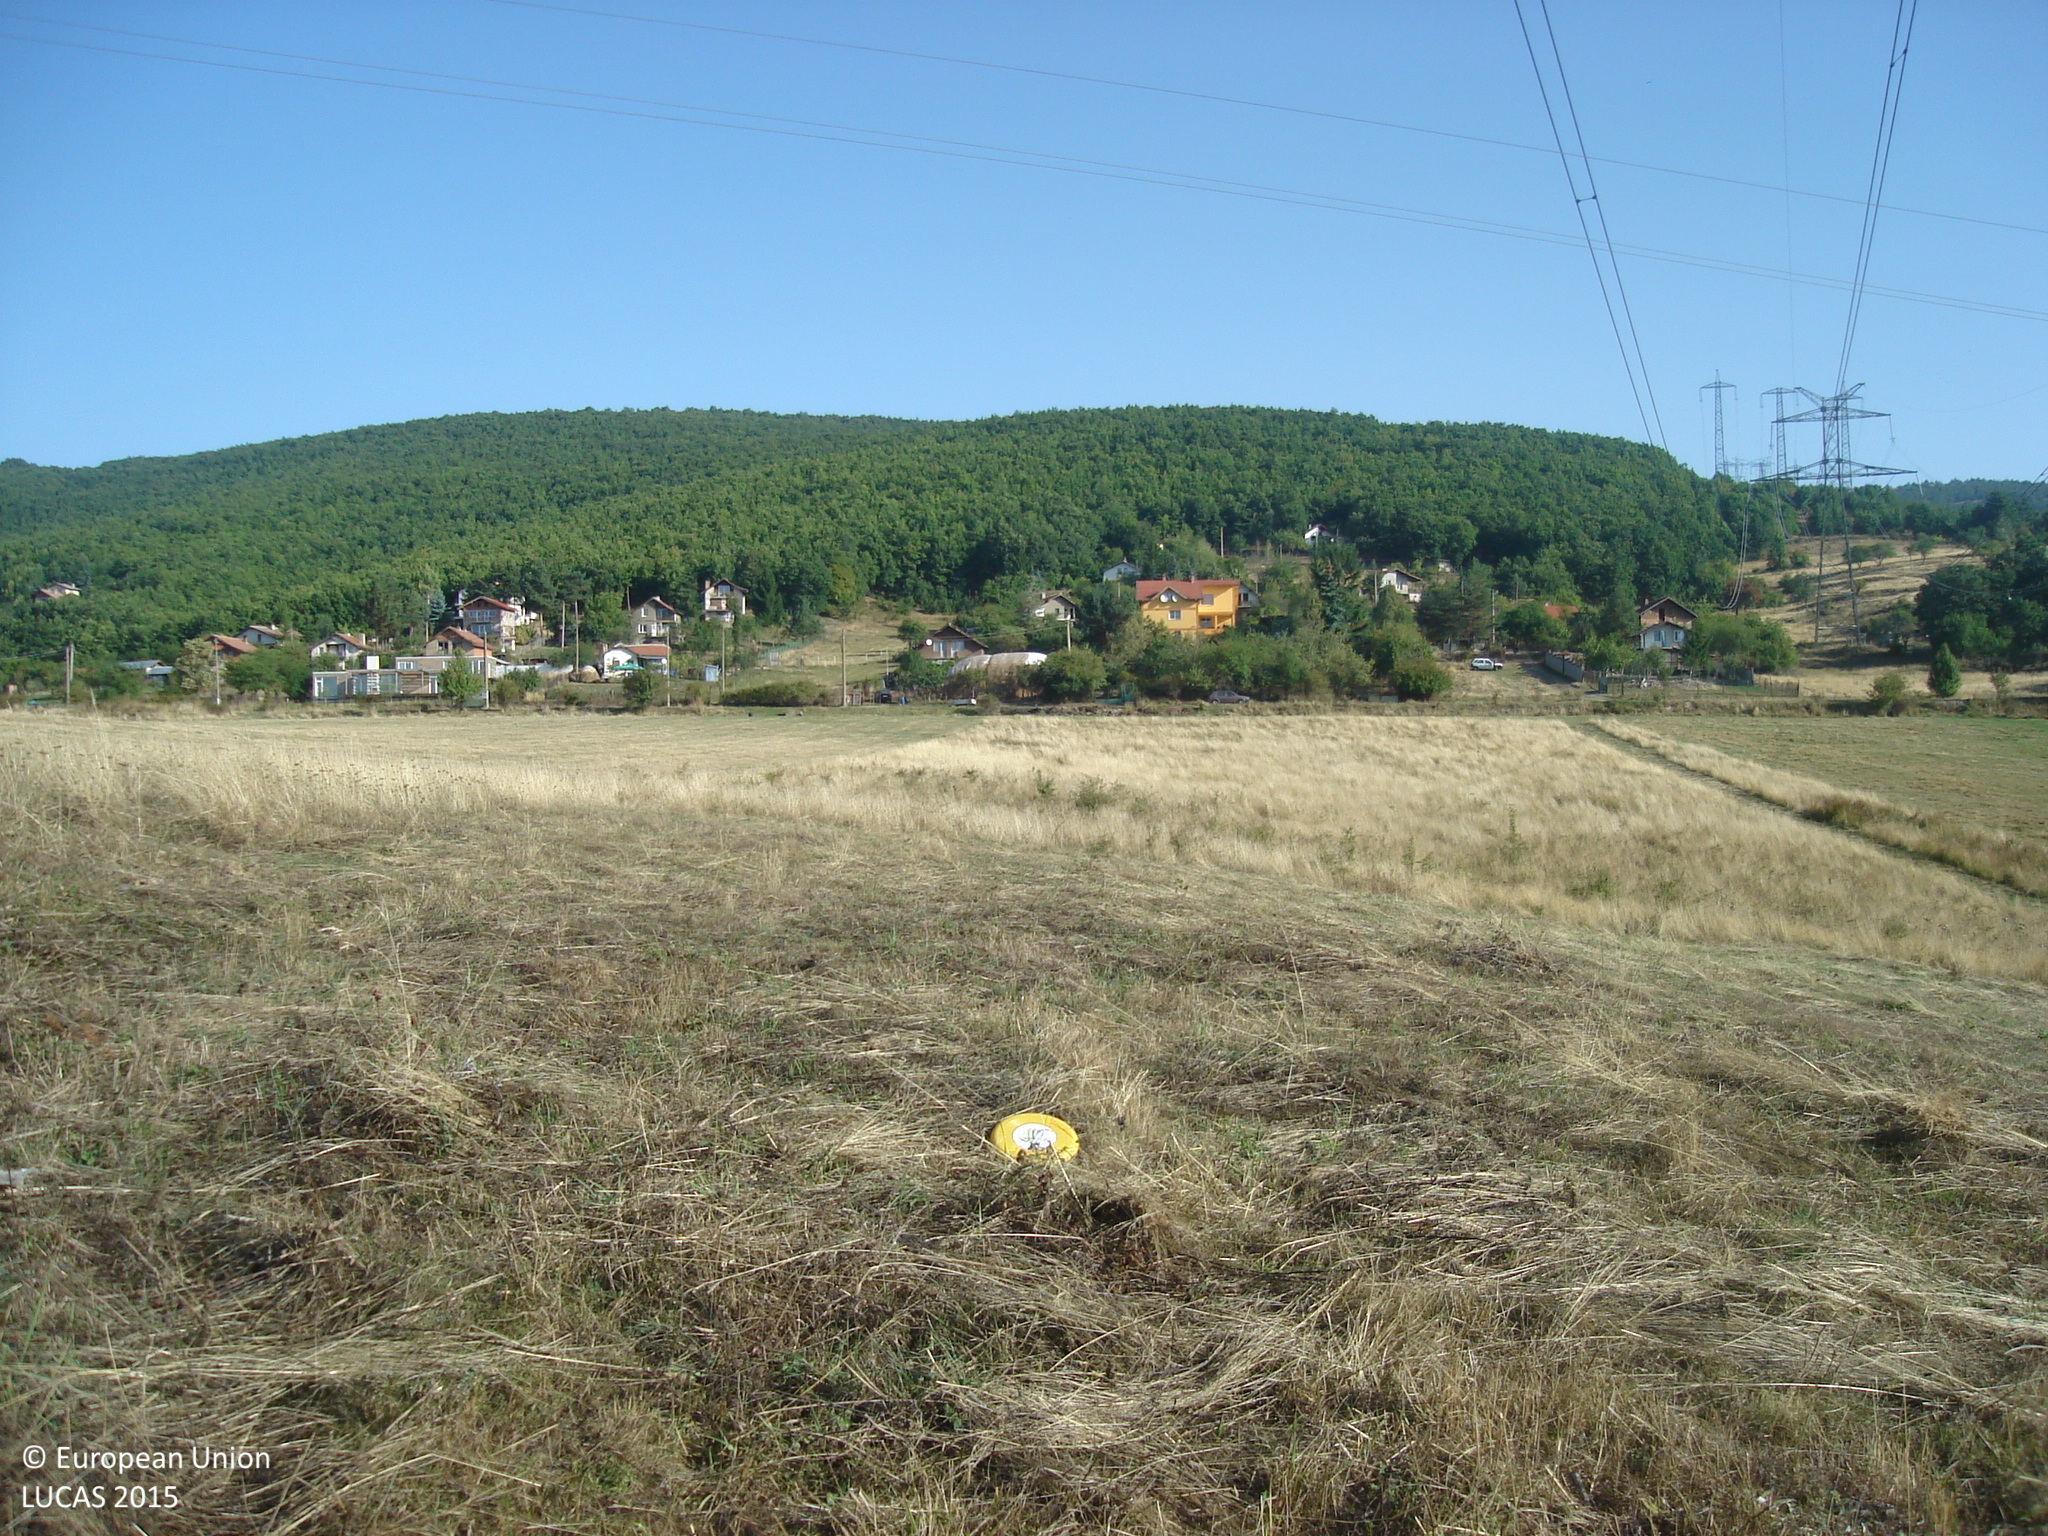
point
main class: Grassland
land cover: Grassland without tree/shrub cover
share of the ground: > 75 %
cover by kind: herbaceous plants 100 %
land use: Agriculture (excluding fallow land and kitchen gardens)
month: September
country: BG
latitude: 42.9328
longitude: 23.2322
